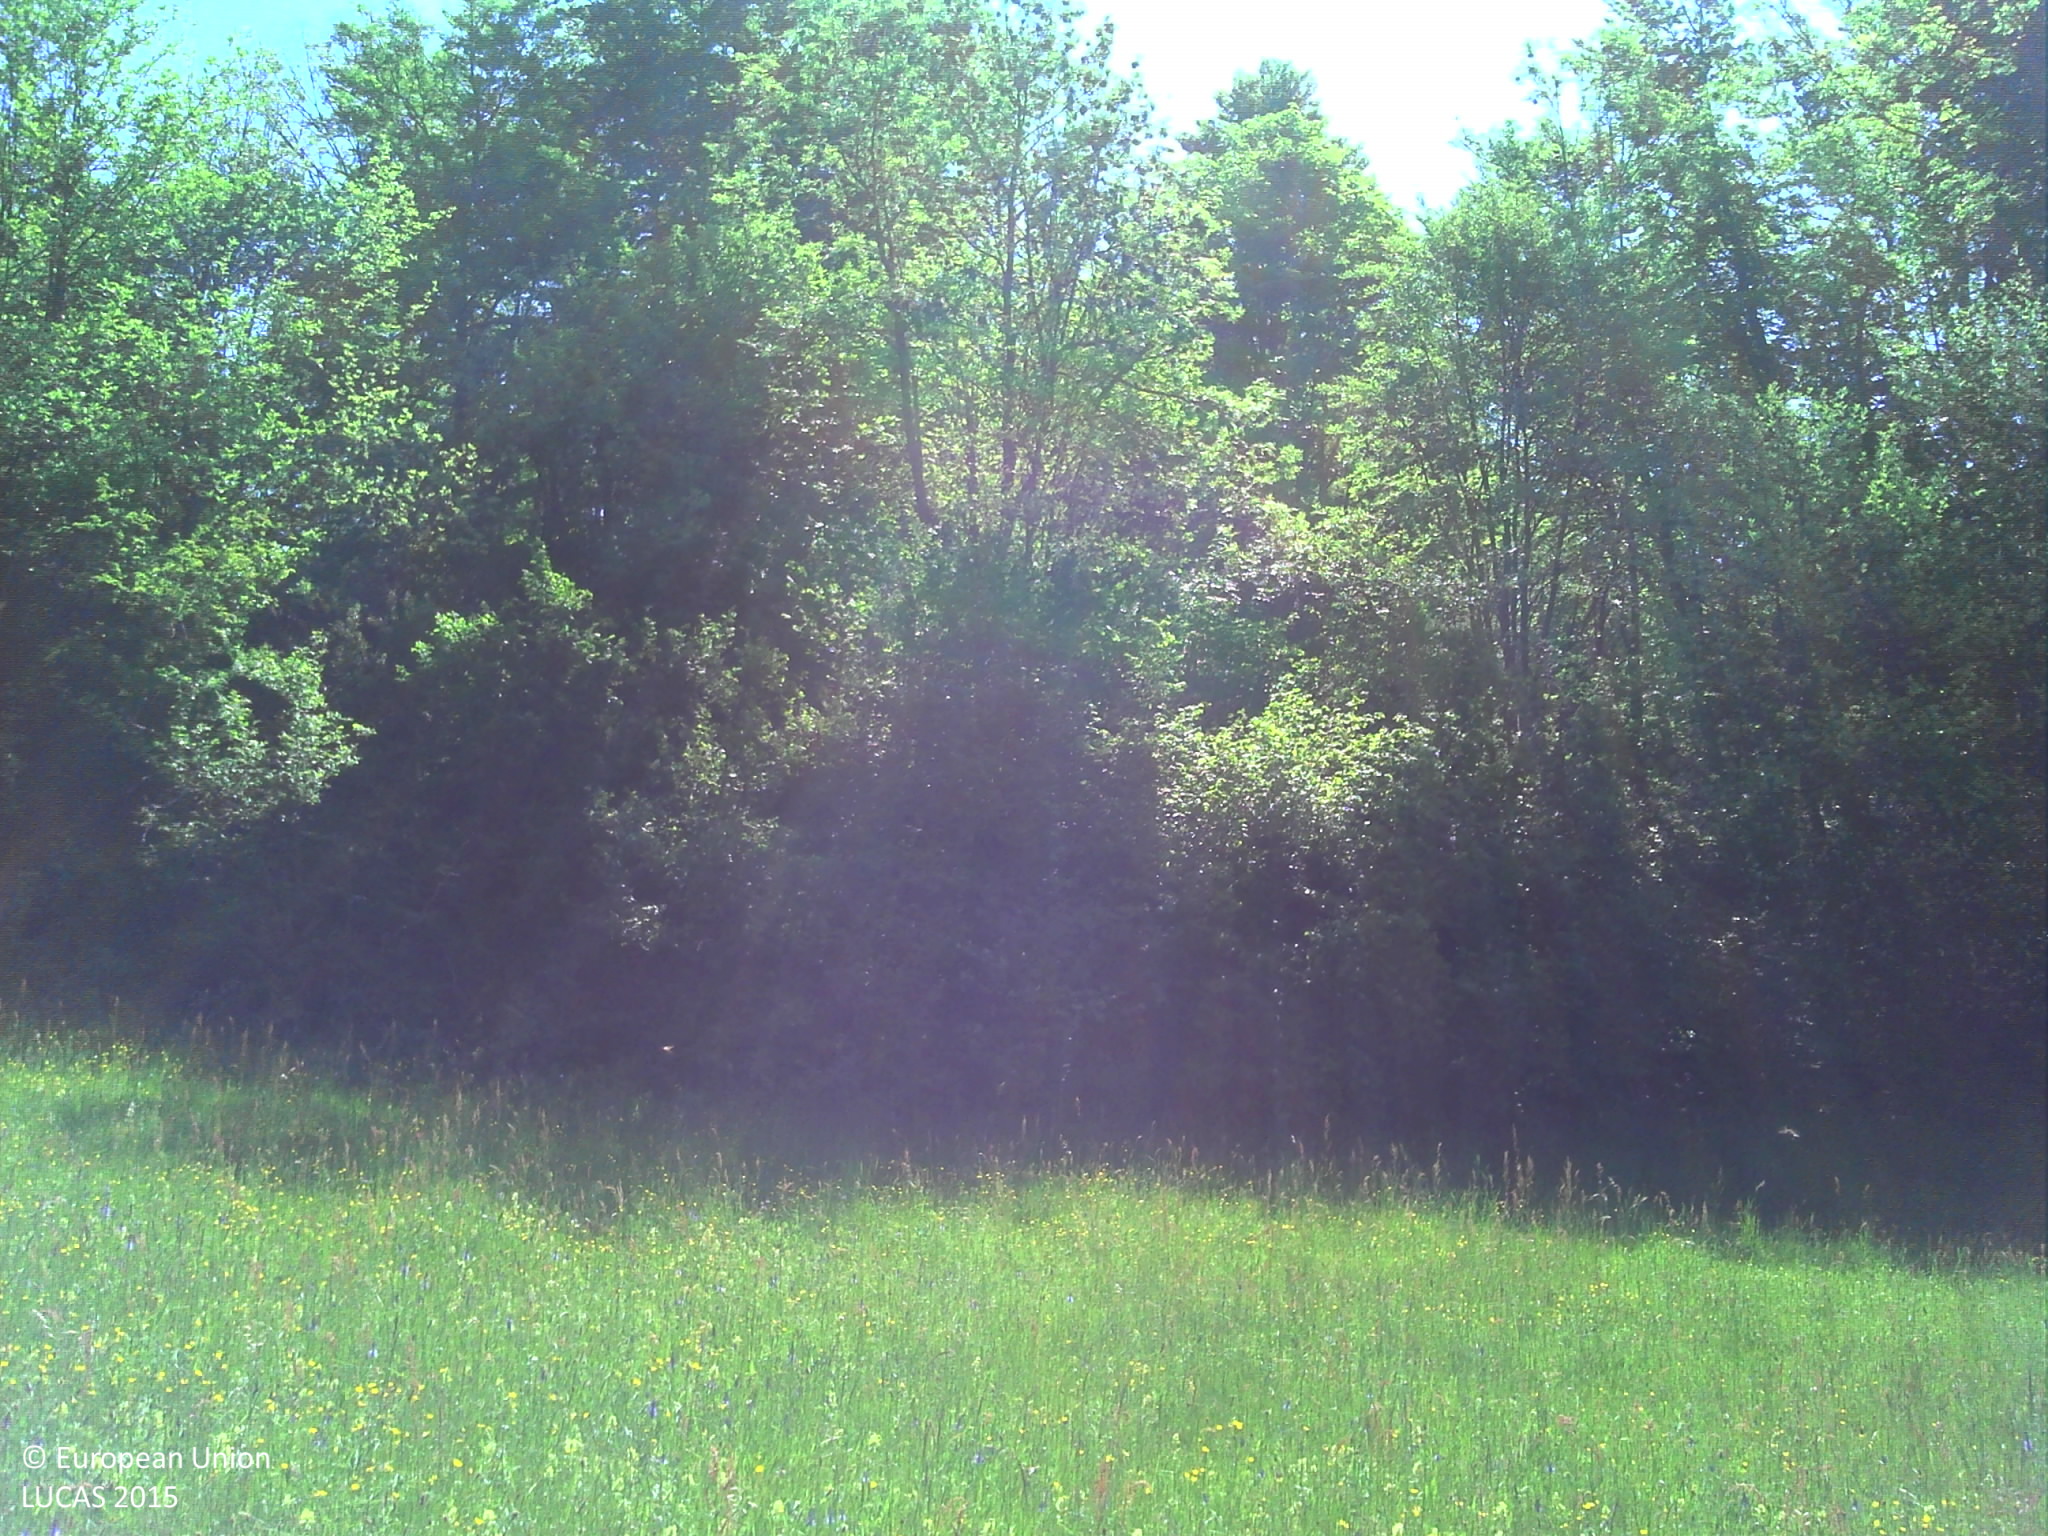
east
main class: Grassland
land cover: Grassland without tree/shrub cover
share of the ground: > 75 %
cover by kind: herbaceous plants 100 %
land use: Agriculture (excluding fallow land and kitchen gardens)
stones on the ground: < 10 %
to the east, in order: Grassland without tree/shrub cover; Broadleaved woodland; Tracks; Broadleaved woodland; Tracks; Broadleaved woodland
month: June
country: FR
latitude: 44.9811
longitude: 5.2248
